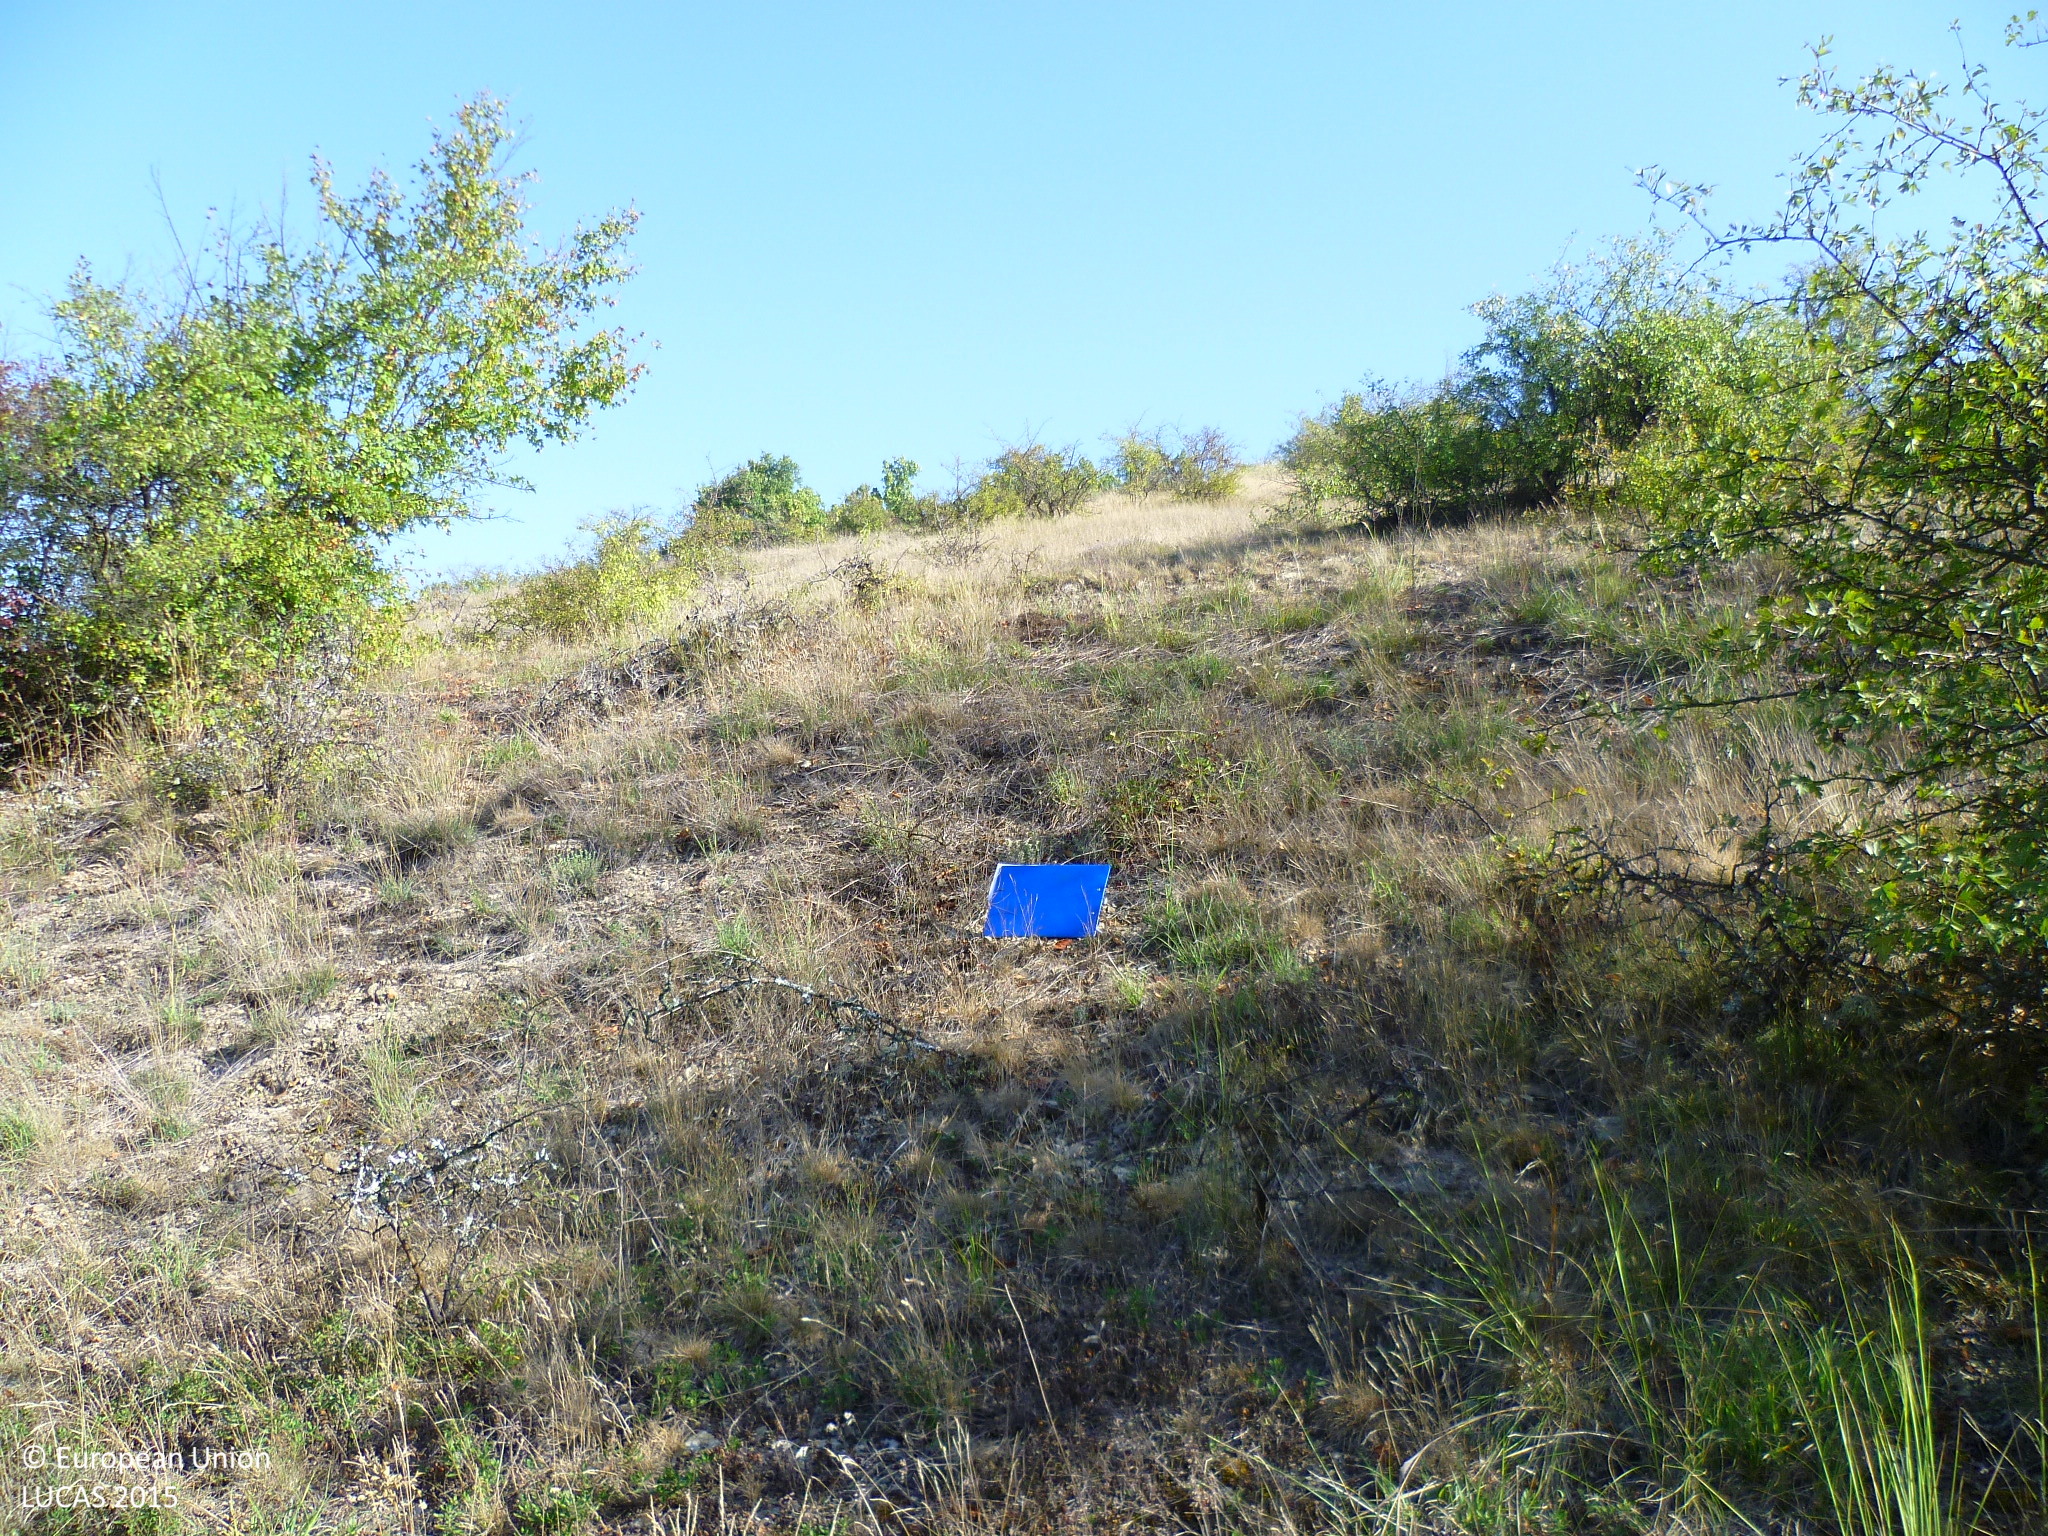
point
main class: Shrubland
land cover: Shrubland with sparse tree cover
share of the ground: 50 - 75 %
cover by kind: shrubs 55 %, herbaceous plants 40 %, broadleaved forest trees 5 %
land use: Semi-natural and natural areas not in use
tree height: < 5 m
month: September
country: BG
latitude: 42.8816
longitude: 22.9226
